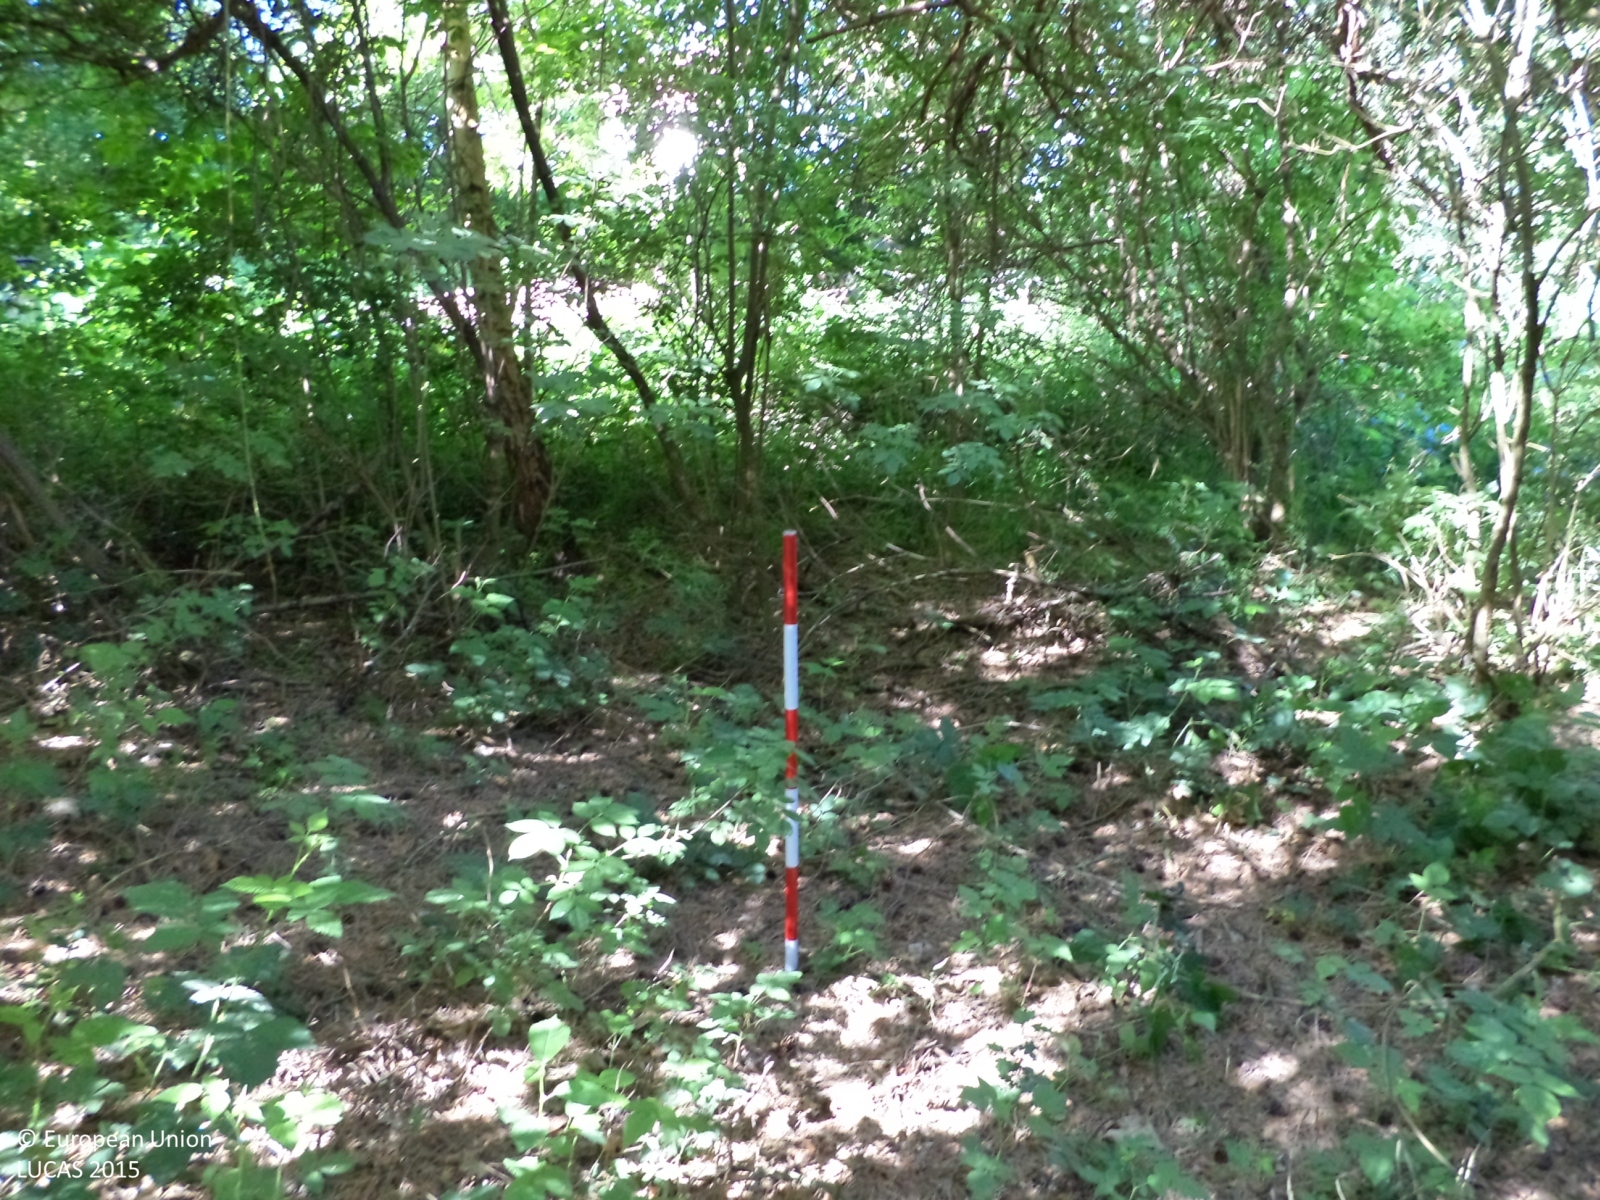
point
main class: Grassland
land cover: Spontaneously vegetated surfaces
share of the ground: > 75 %
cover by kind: herbaceous plants 95 %, shrubs 5 %
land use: Fallow land
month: June
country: CZ
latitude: 49.6445
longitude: 14.9465
